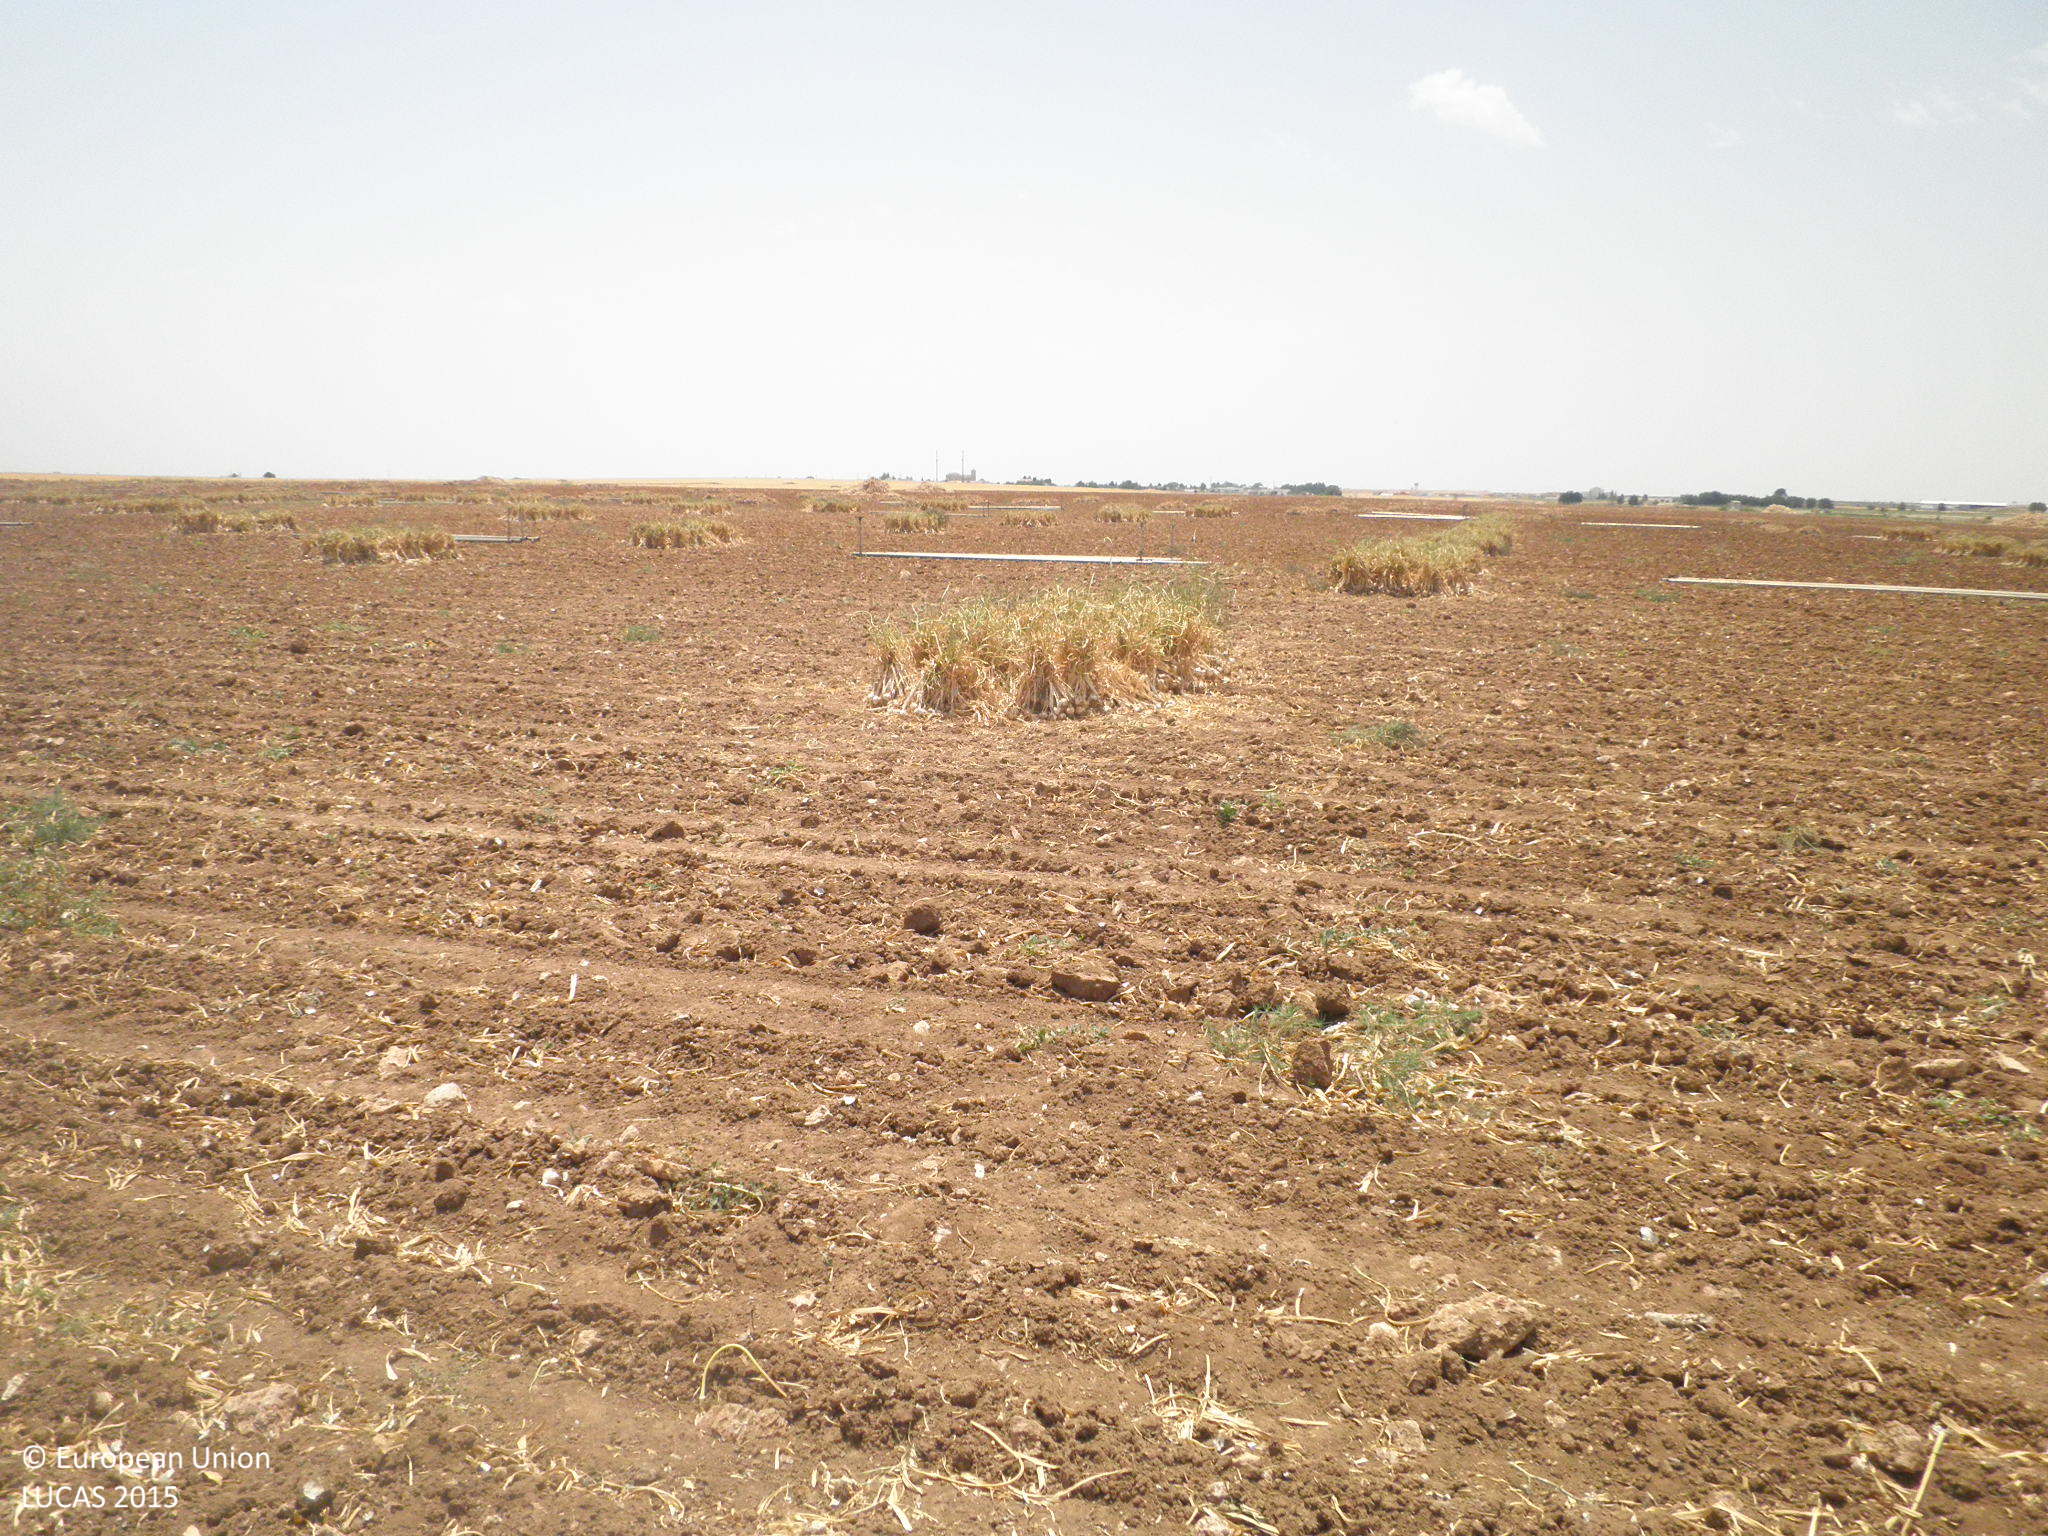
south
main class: Cropland
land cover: Other root crops
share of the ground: < 10 %
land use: Agriculture (excluding fallow land and kitchen gardens)
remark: Harvested field
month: July
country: ES
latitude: 39.5051
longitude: -2.7492
